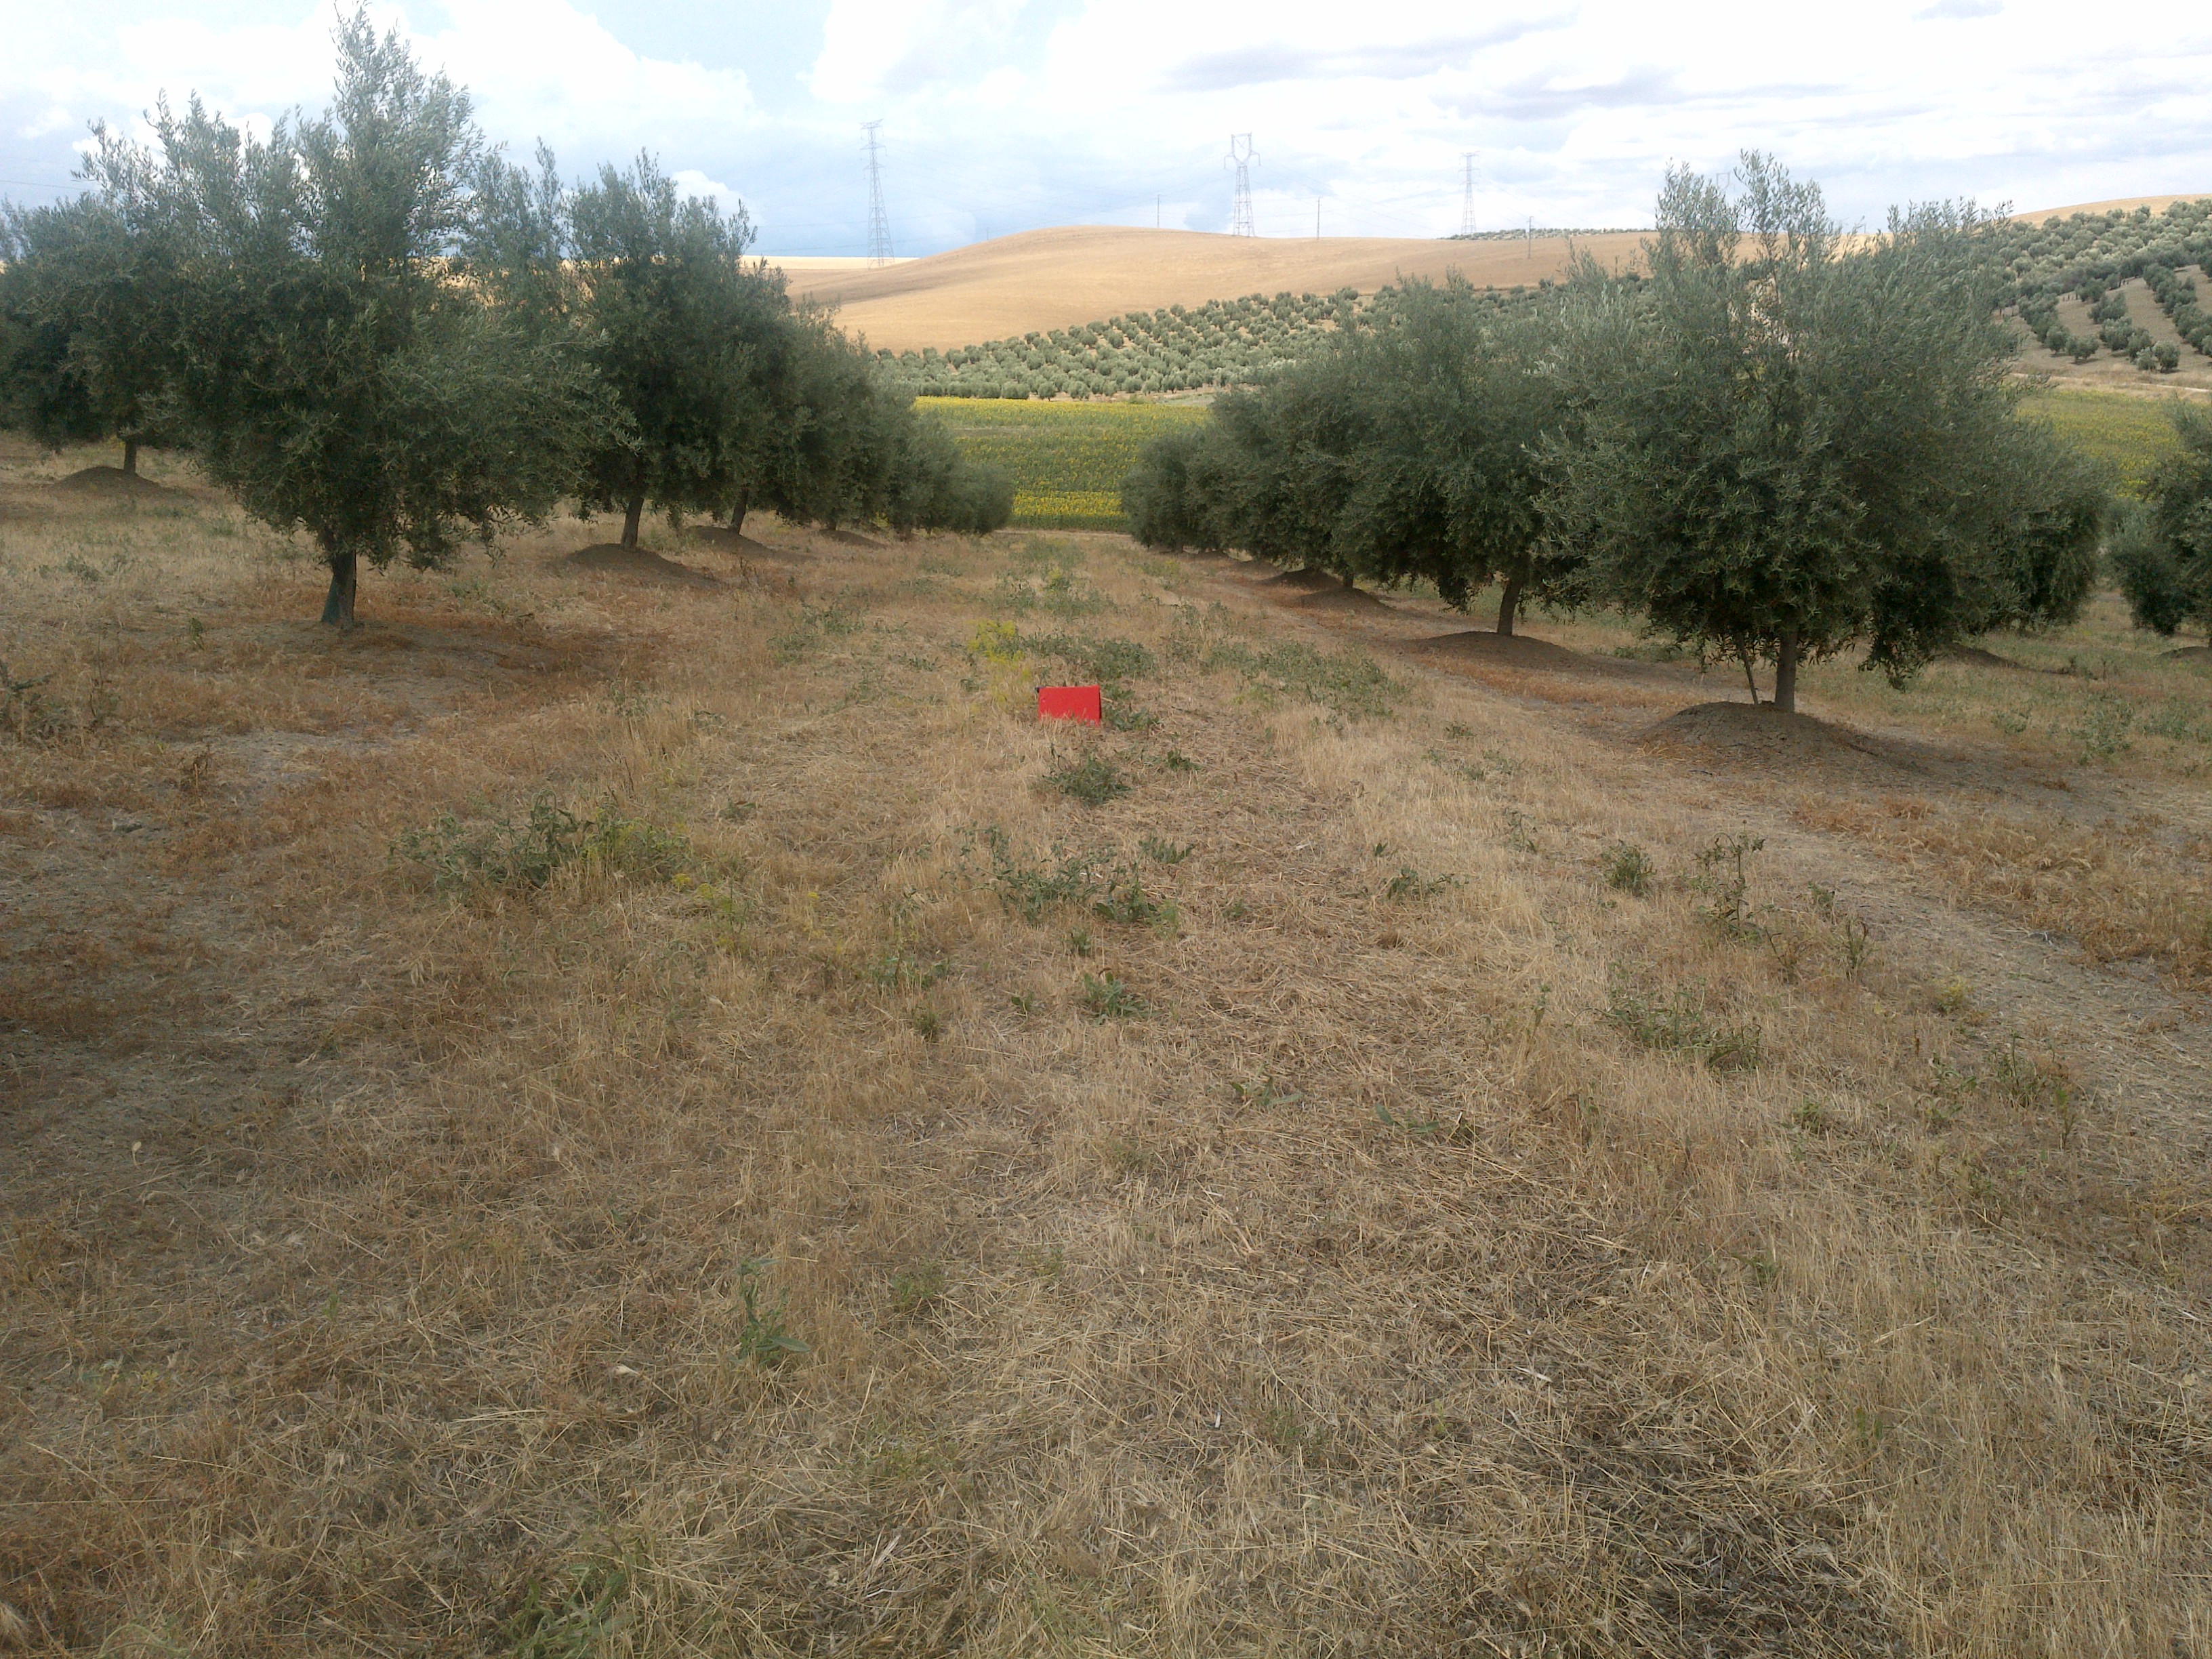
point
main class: Cropland
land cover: Olive groves
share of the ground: 25 - 50 %
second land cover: Spontaneously vegetated surfaces
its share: 10 - 25 %
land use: Agriculture (excluding fallow land and kitchen gardens)
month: June
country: ES
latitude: 37.8384
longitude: -4.2907
